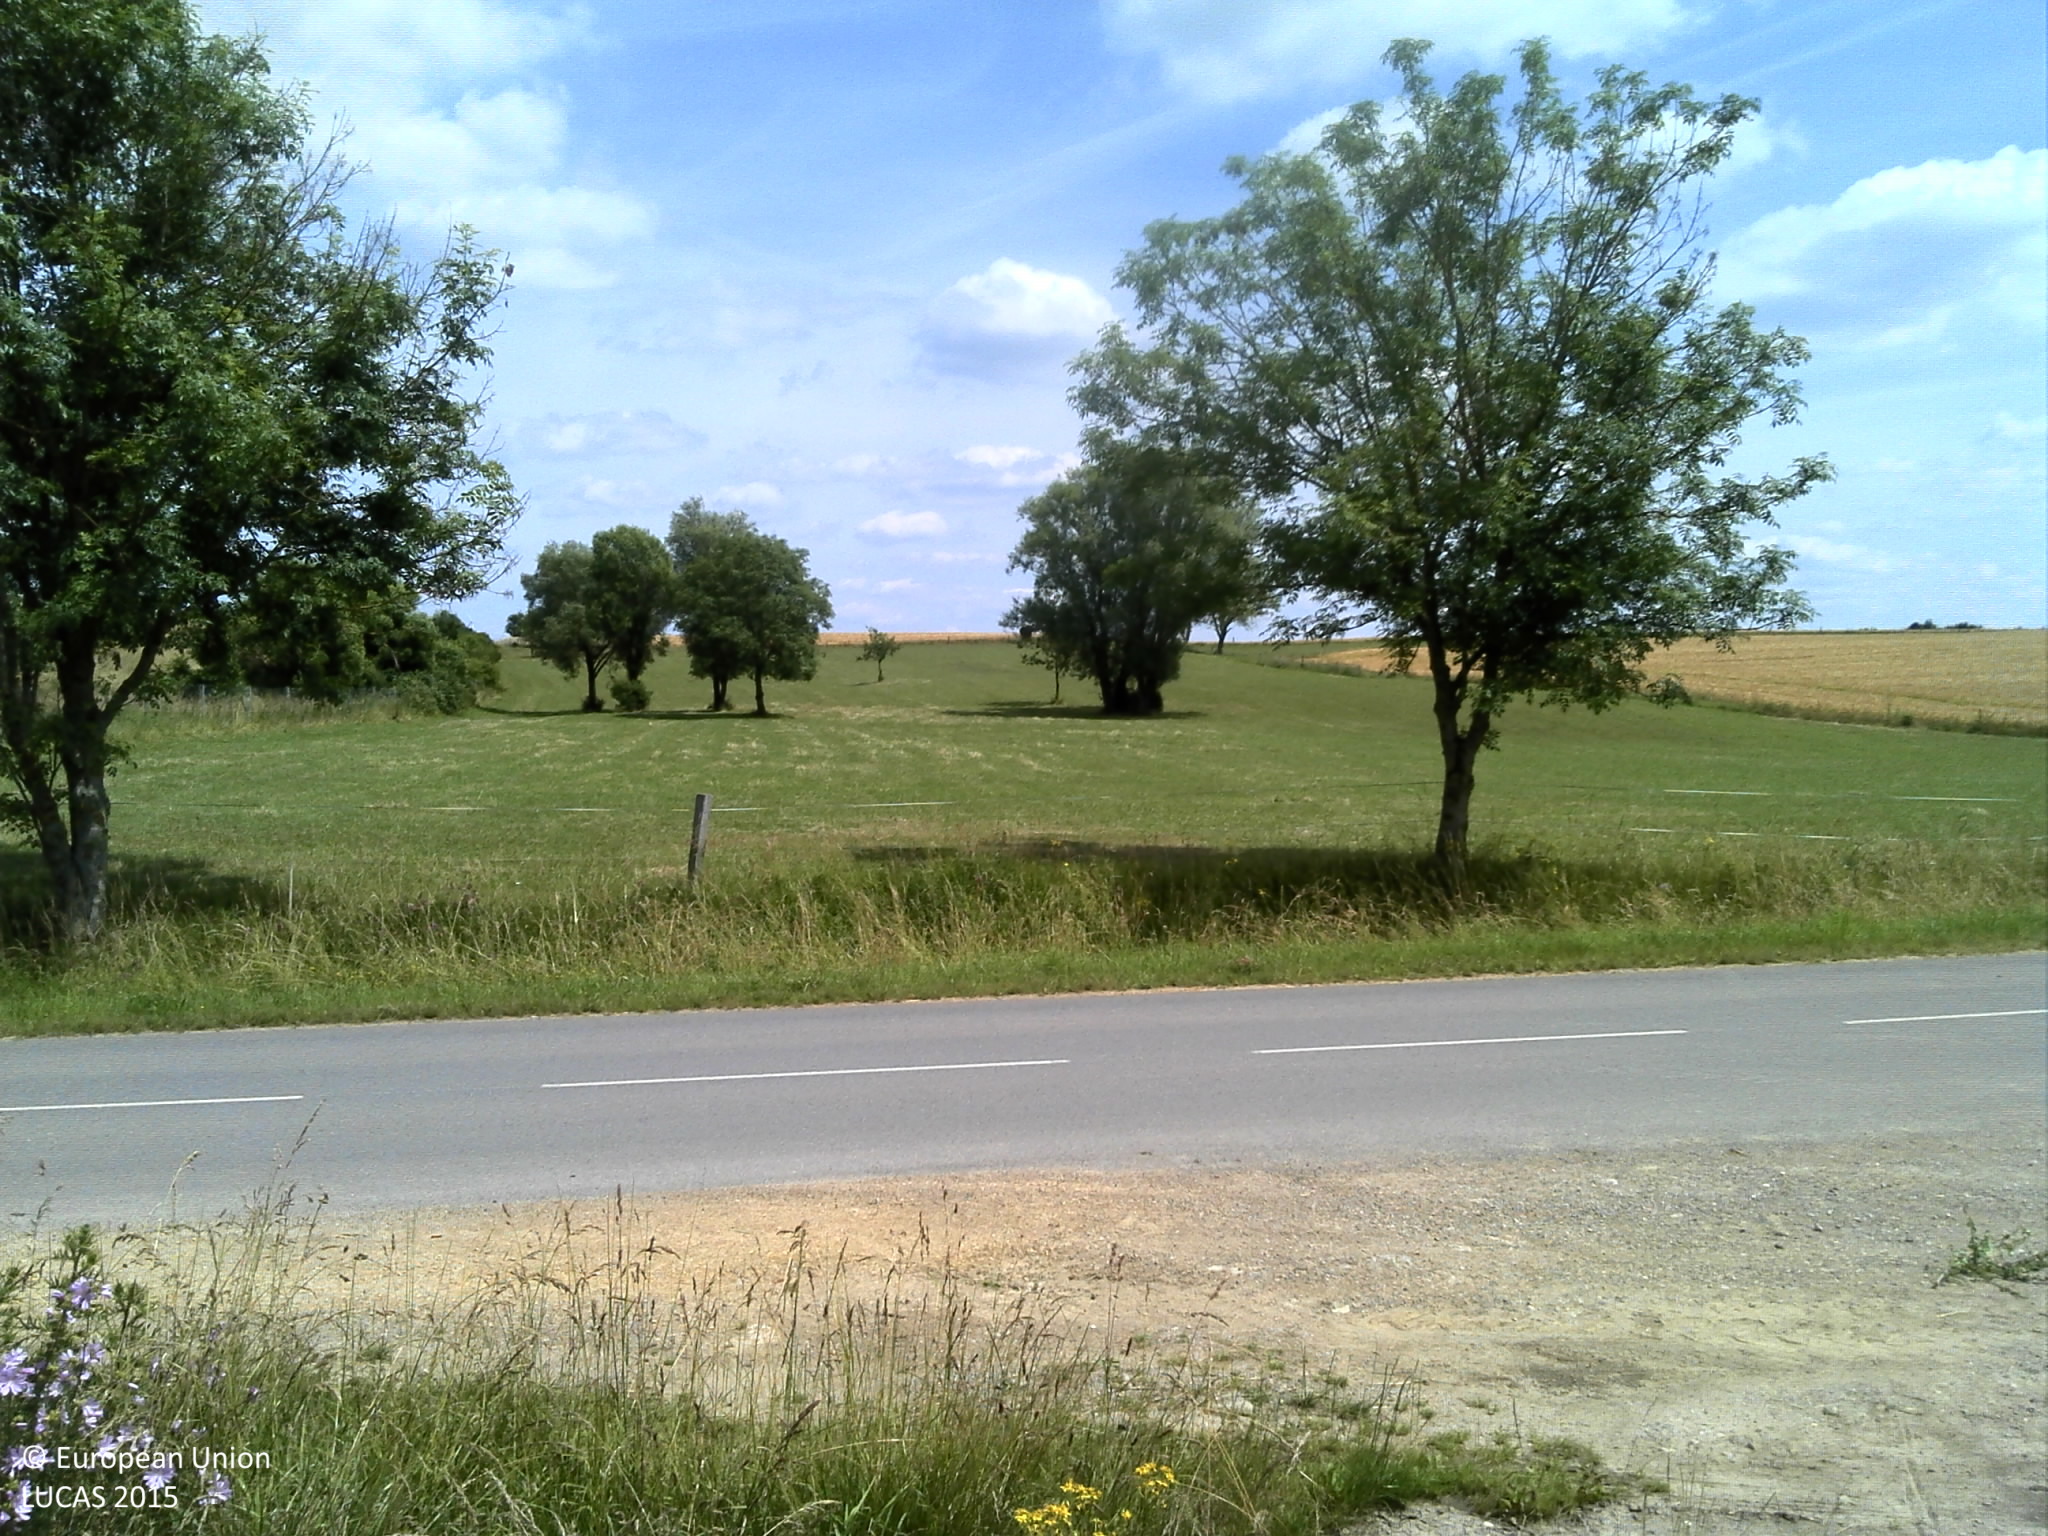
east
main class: Cropland
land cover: Rape and turnip rape
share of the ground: > 75 %
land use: Agriculture (excluding fallow land and kitchen gardens)
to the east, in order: Rape and turnip rape; Grass margins; Ditches and canals; Grass margins; Paved roads, cycling and walking lanes; Grass margins; Ditches and canals; Grass margins; Barley
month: June
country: FR
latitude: 49.1389
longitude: 6.4498
